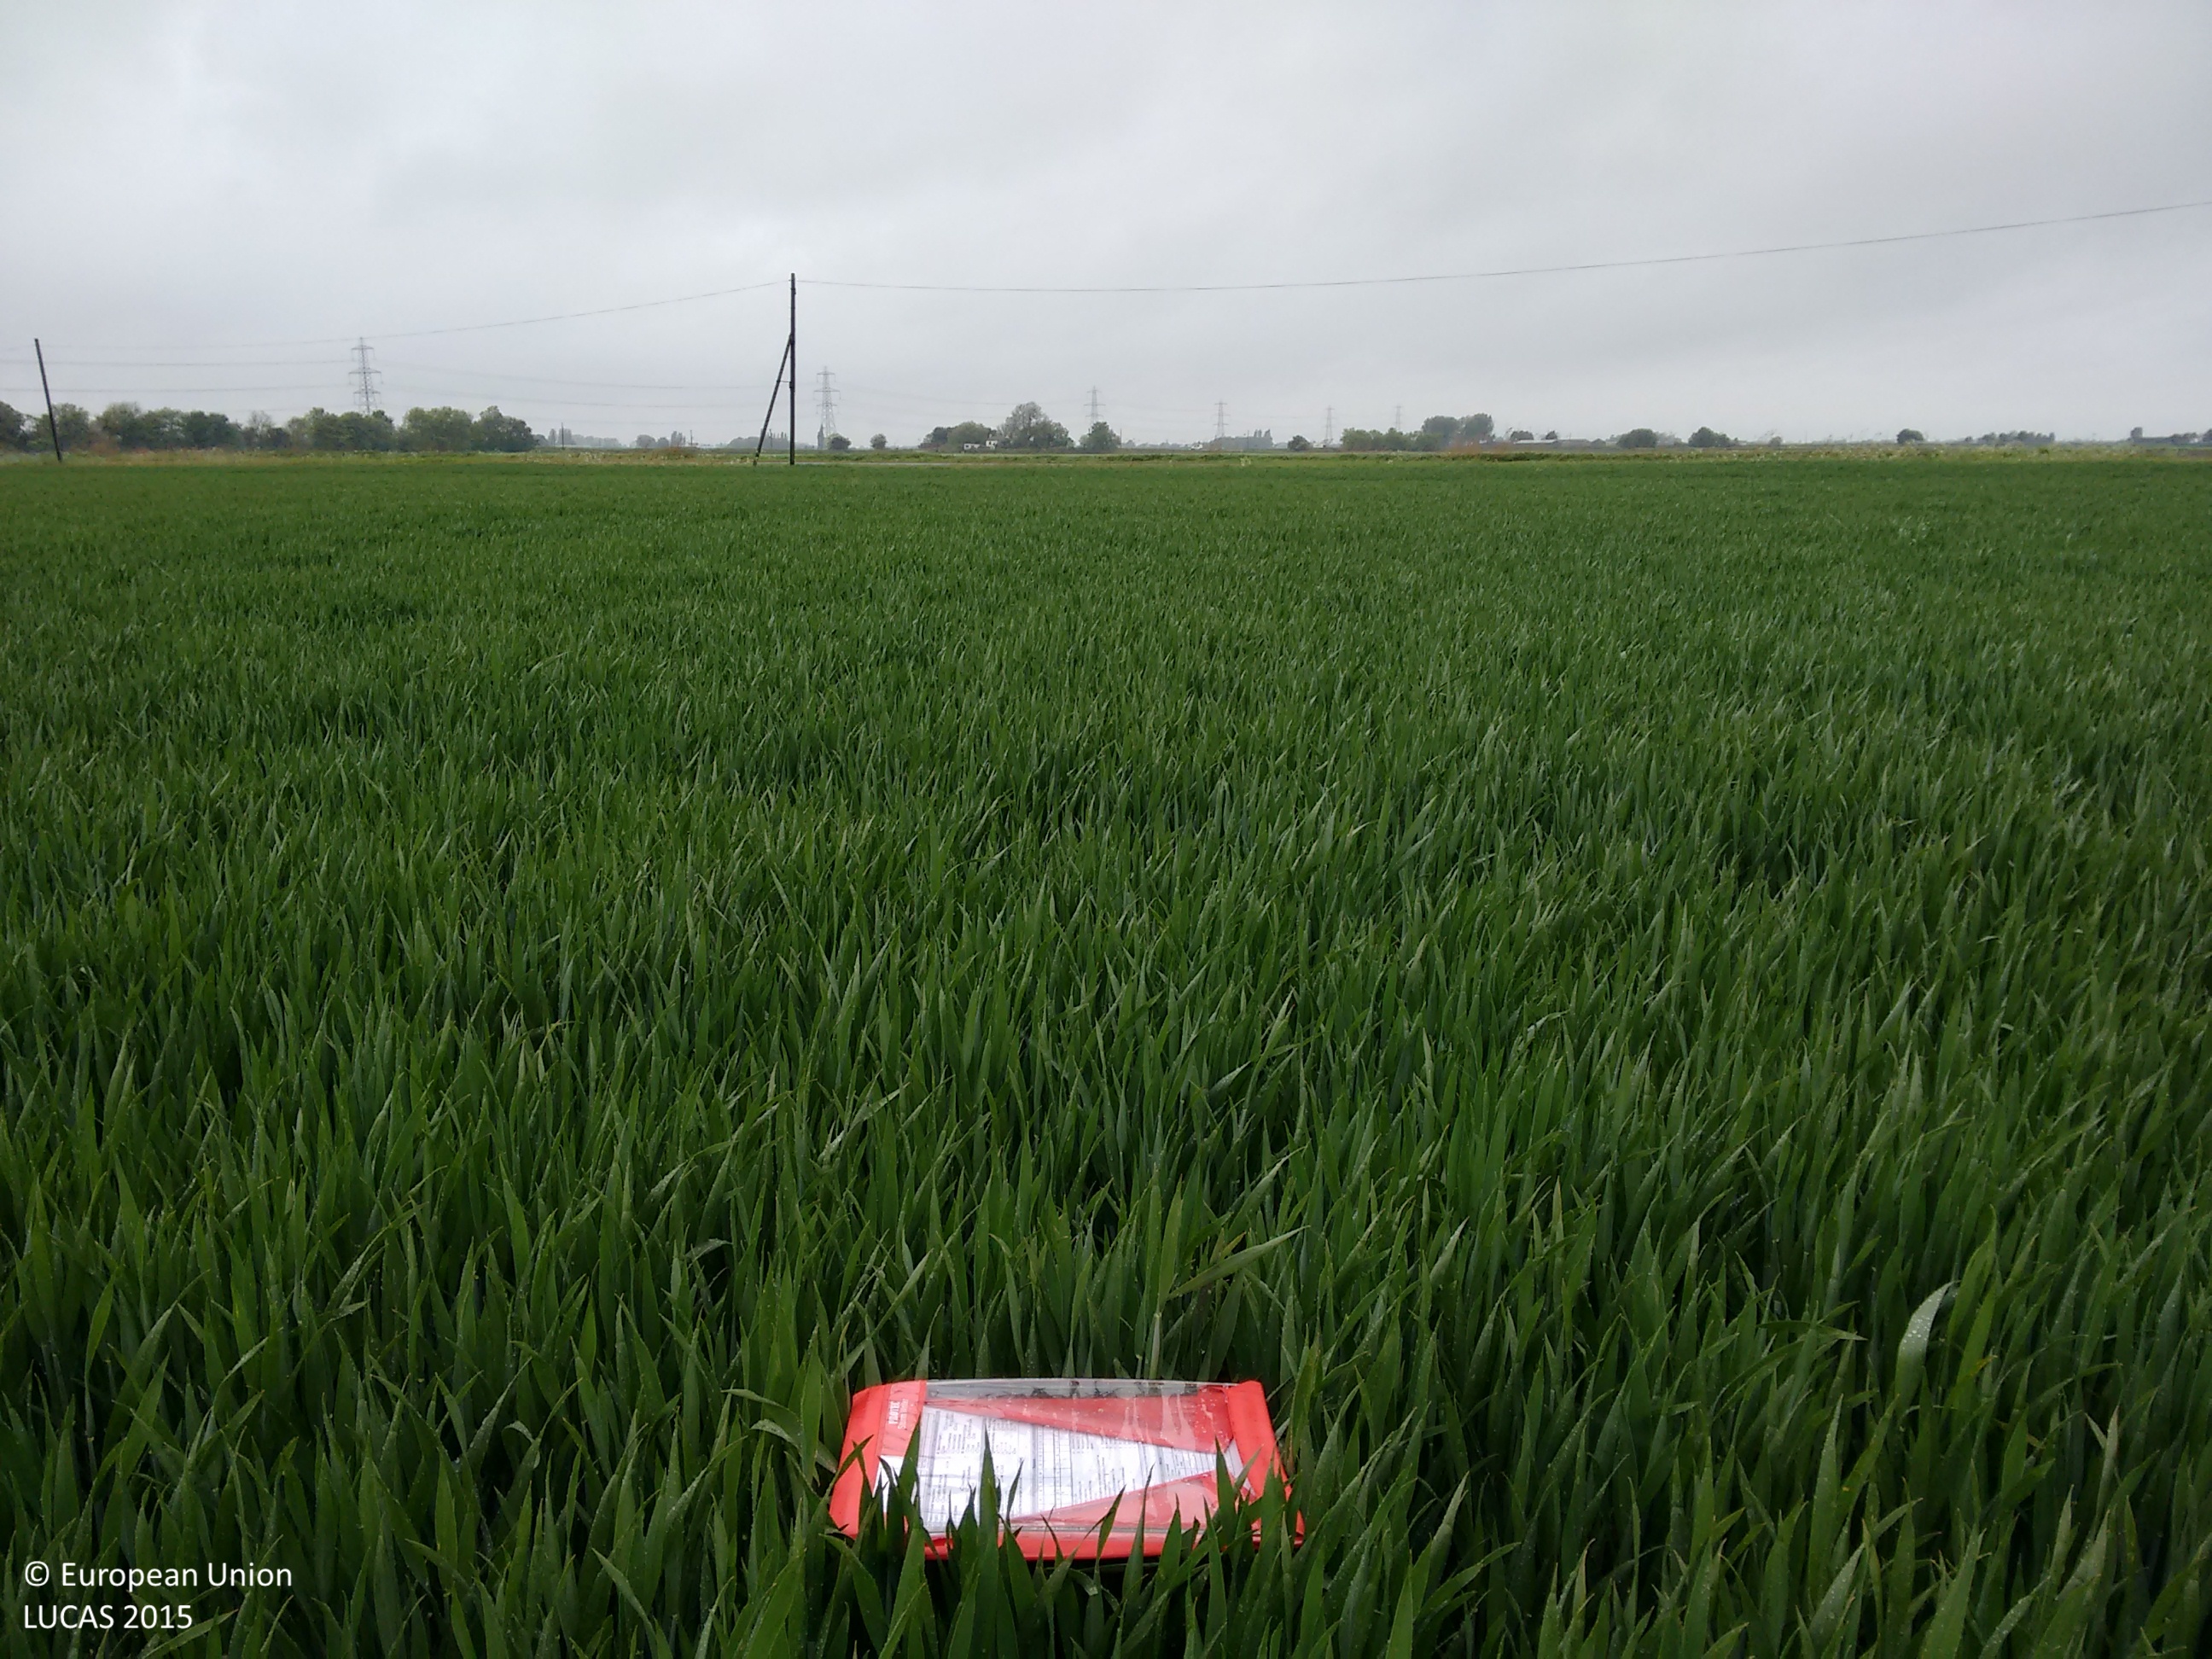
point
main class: Cropland
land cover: Common wheat
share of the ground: > 75 %
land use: Agriculture (excluding fallow land and kitchen gardens)
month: May
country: GB
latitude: 52.8859
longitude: -0.1245
